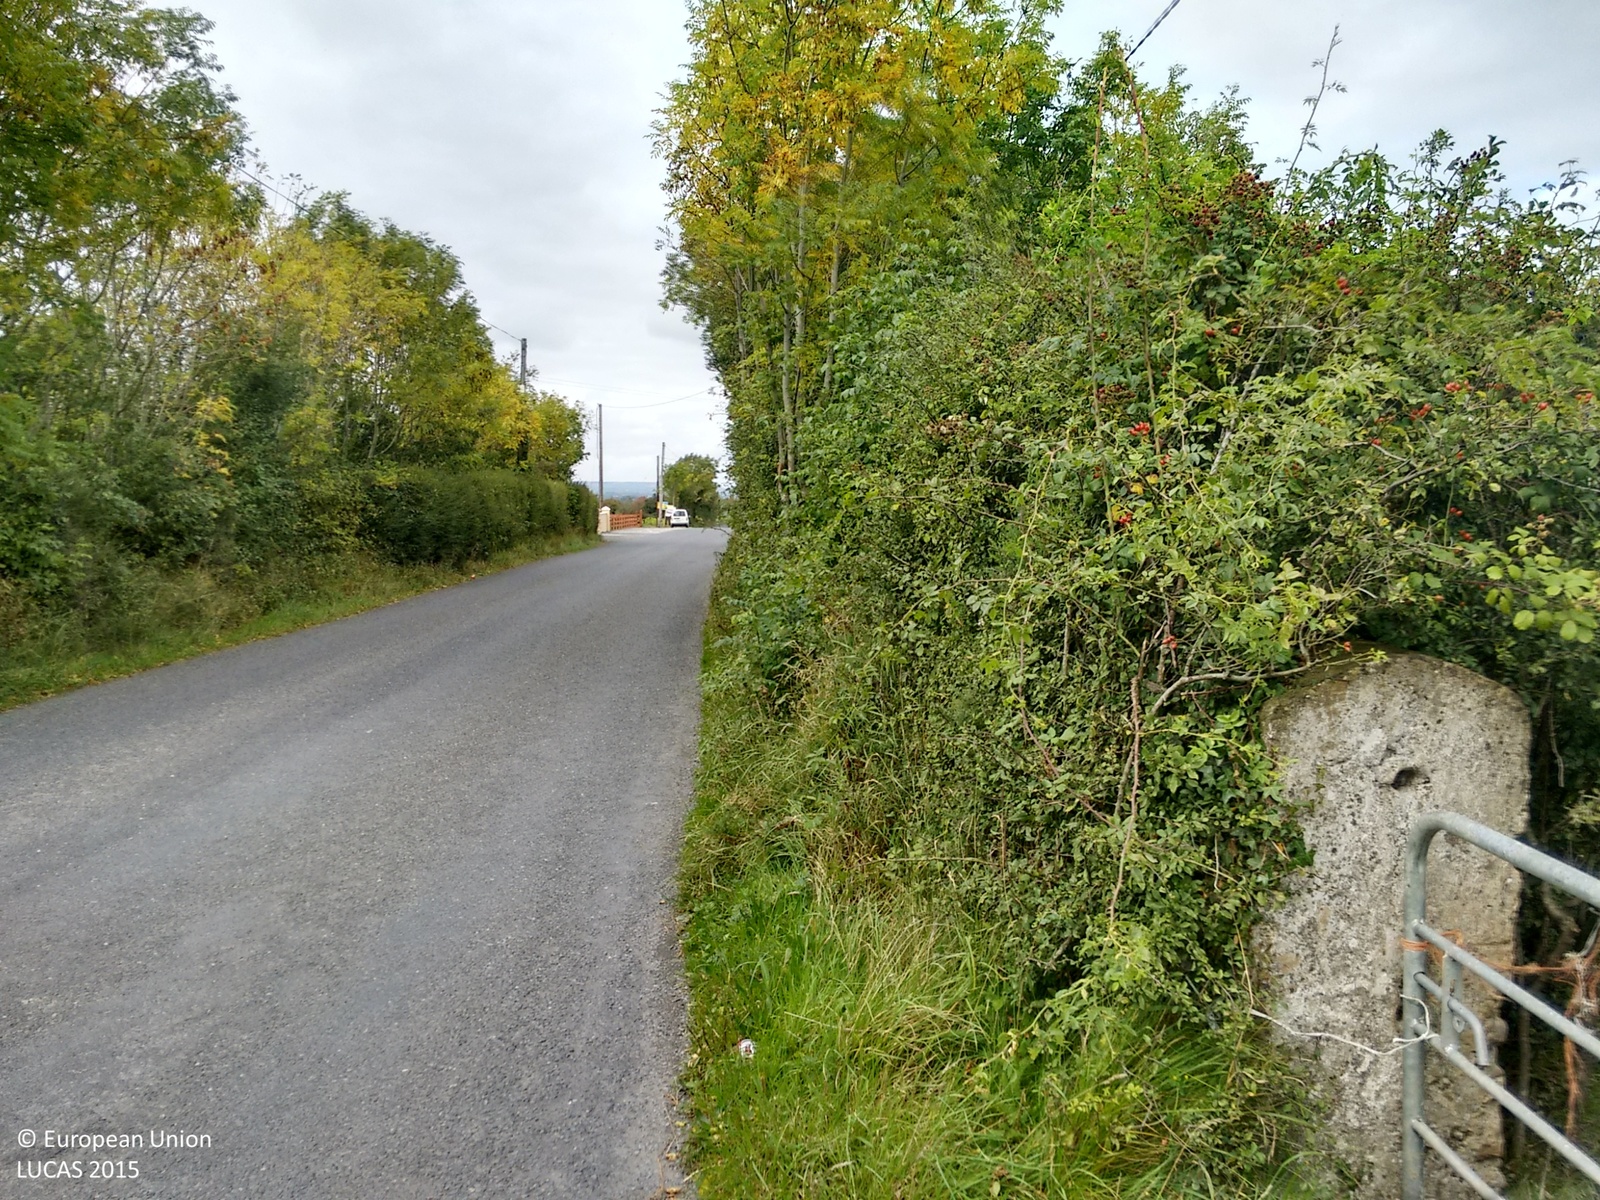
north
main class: Grassland
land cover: Grassland without tree/shrub cover
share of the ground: > 75 %
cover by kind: herbaceous plants 85 %
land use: Agriculture (excluding fallow land and kitchen gardens)
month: September
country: IE
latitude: 52.3758
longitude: -9.0008
